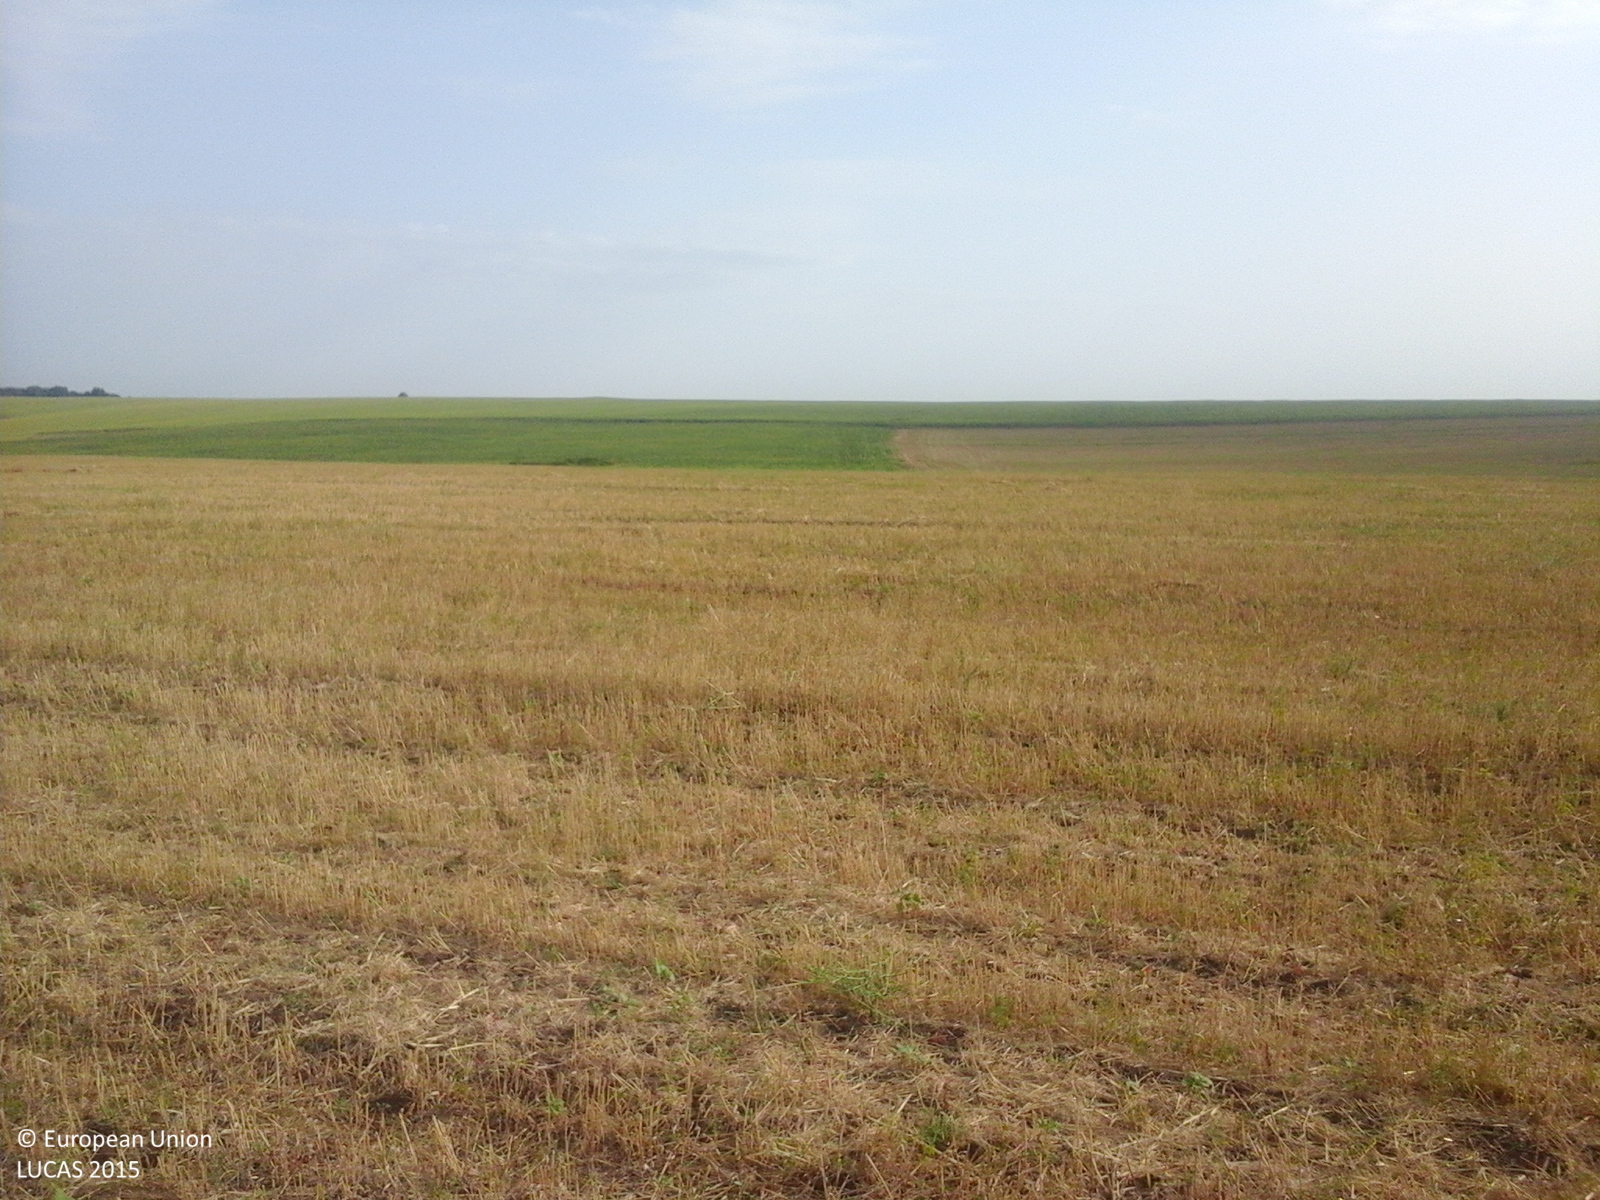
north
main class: Cropland
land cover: Barley
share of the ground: 50 - 75 %
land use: Agriculture (excluding fallow land and kitchen gardens)
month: August
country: RO
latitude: 44.0316
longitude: 27.9049
